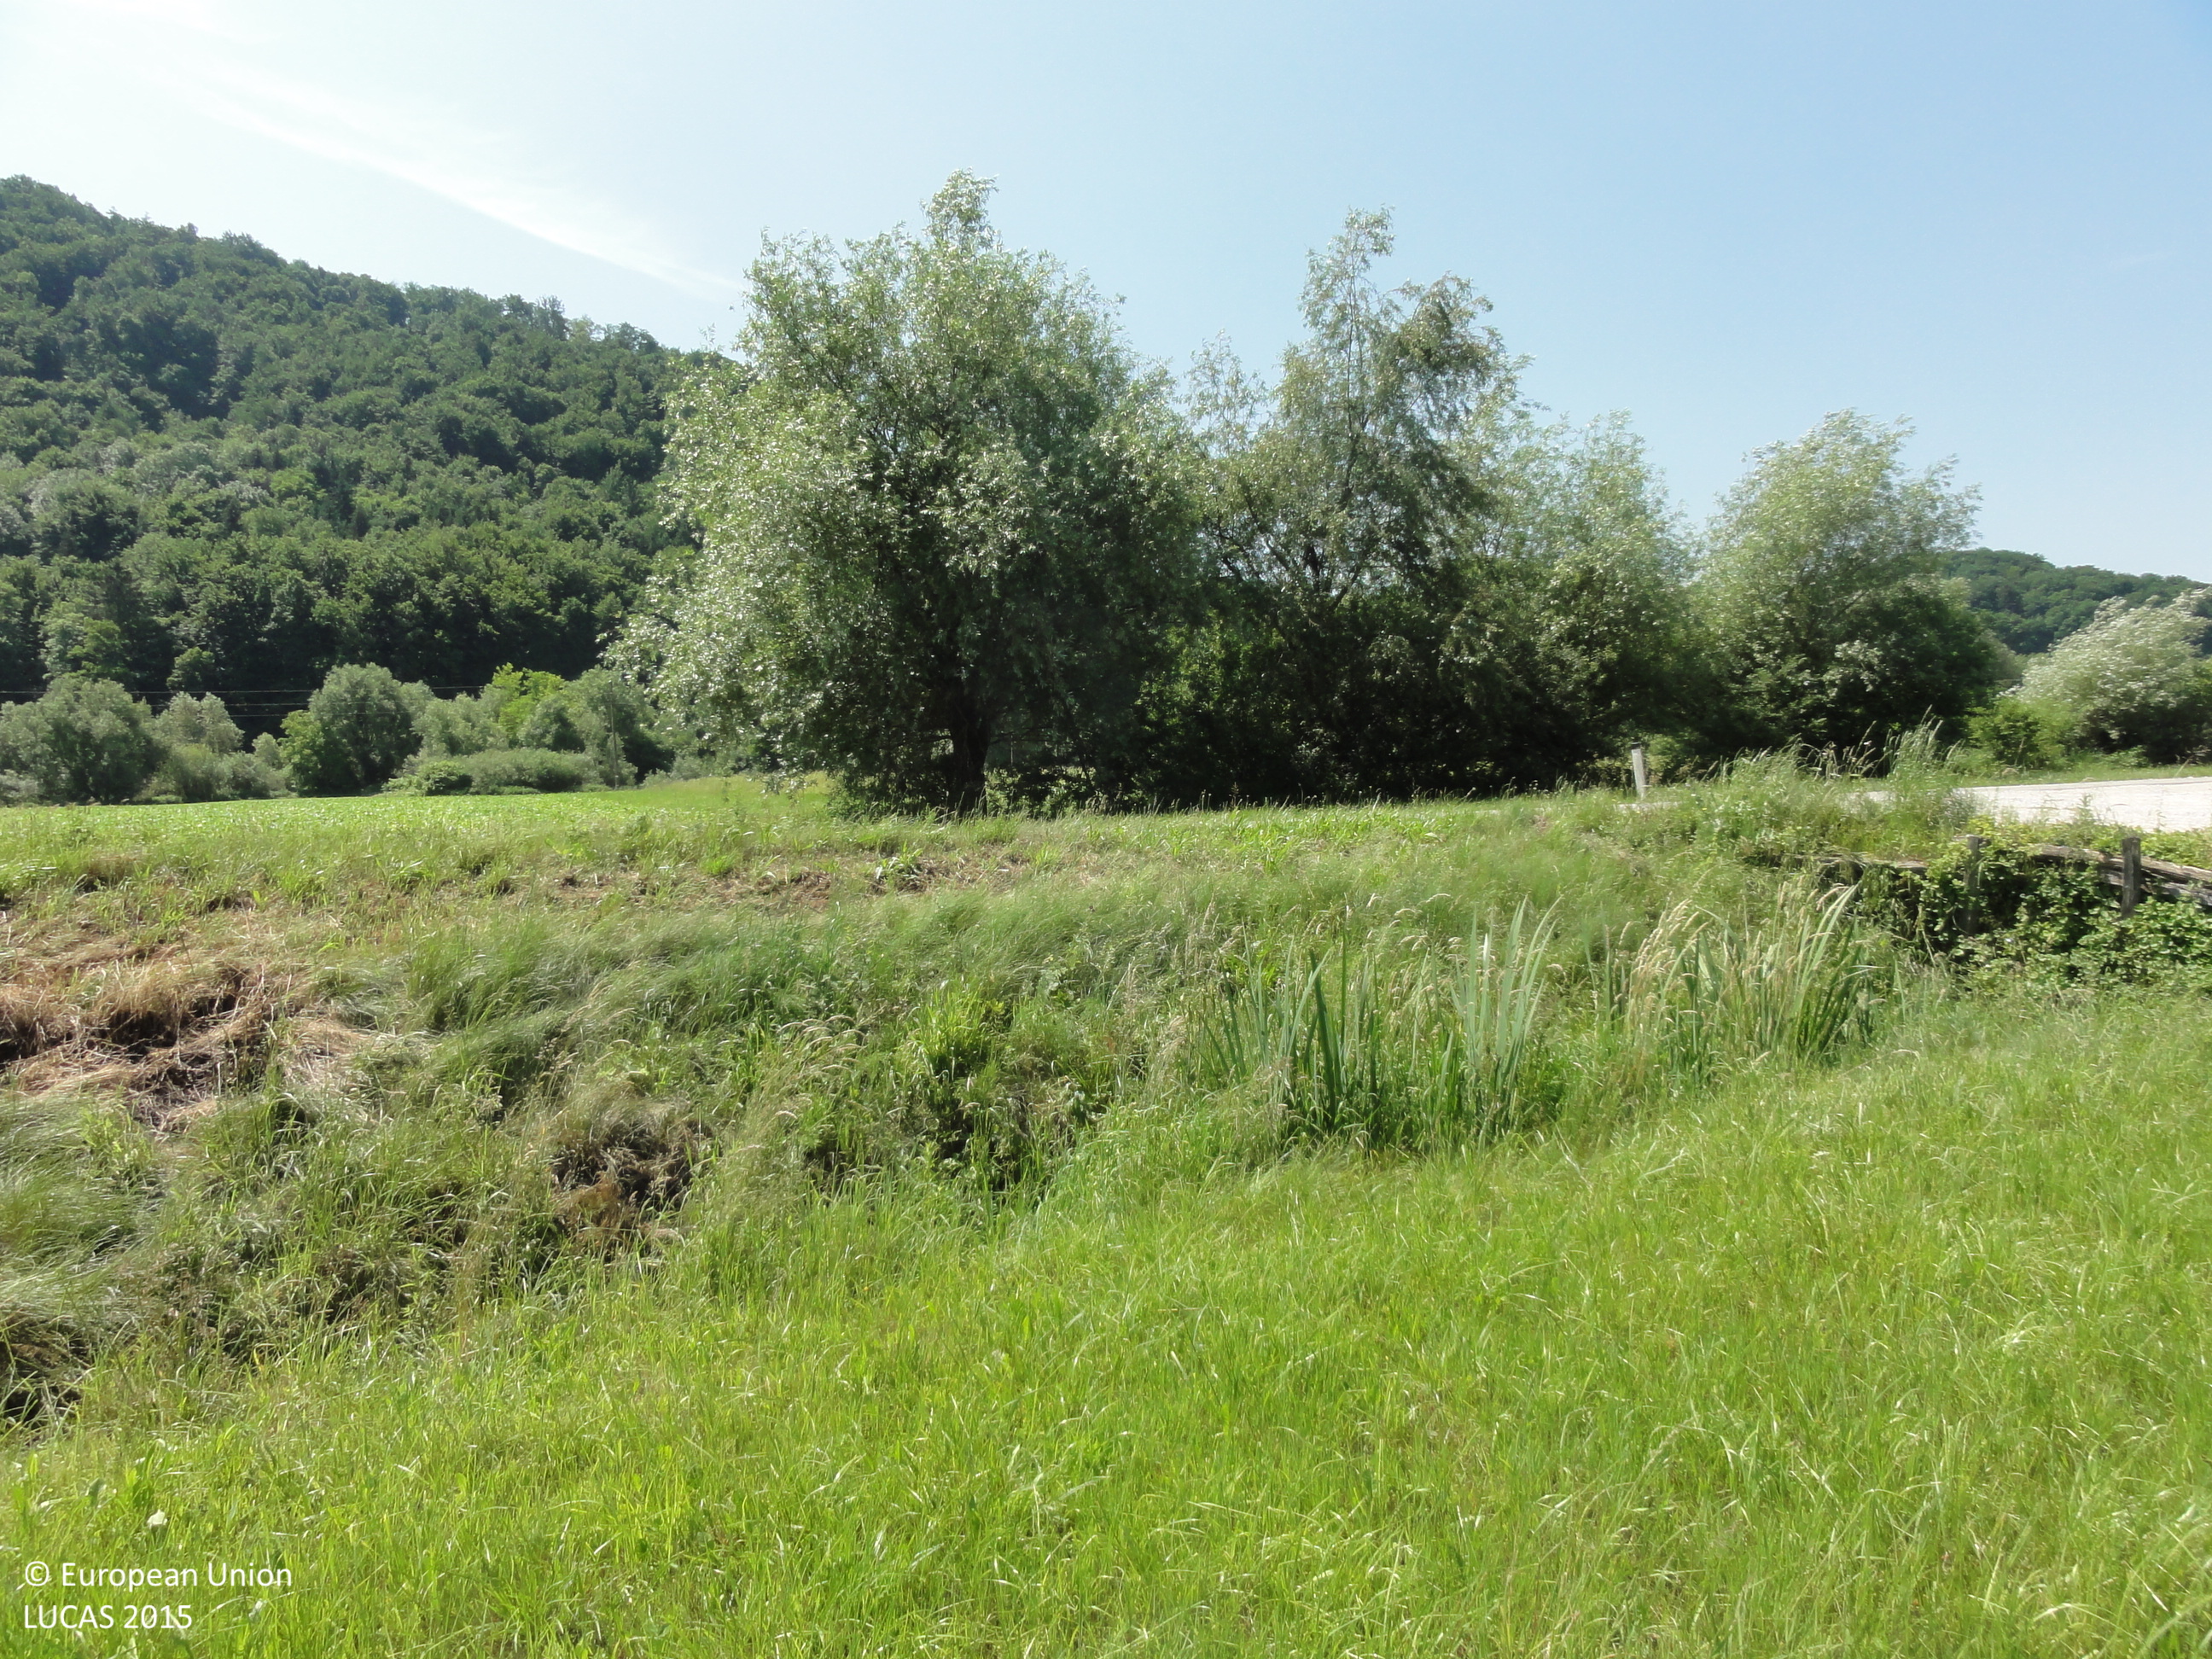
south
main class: Grassland
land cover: Grassland without tree/shrub cover
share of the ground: > 75 %
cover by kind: herbaceous plants 100 %
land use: Agriculture (excluding fallow land and kitchen gardens)
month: June
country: SI
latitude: 46.2992
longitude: 15.5158
